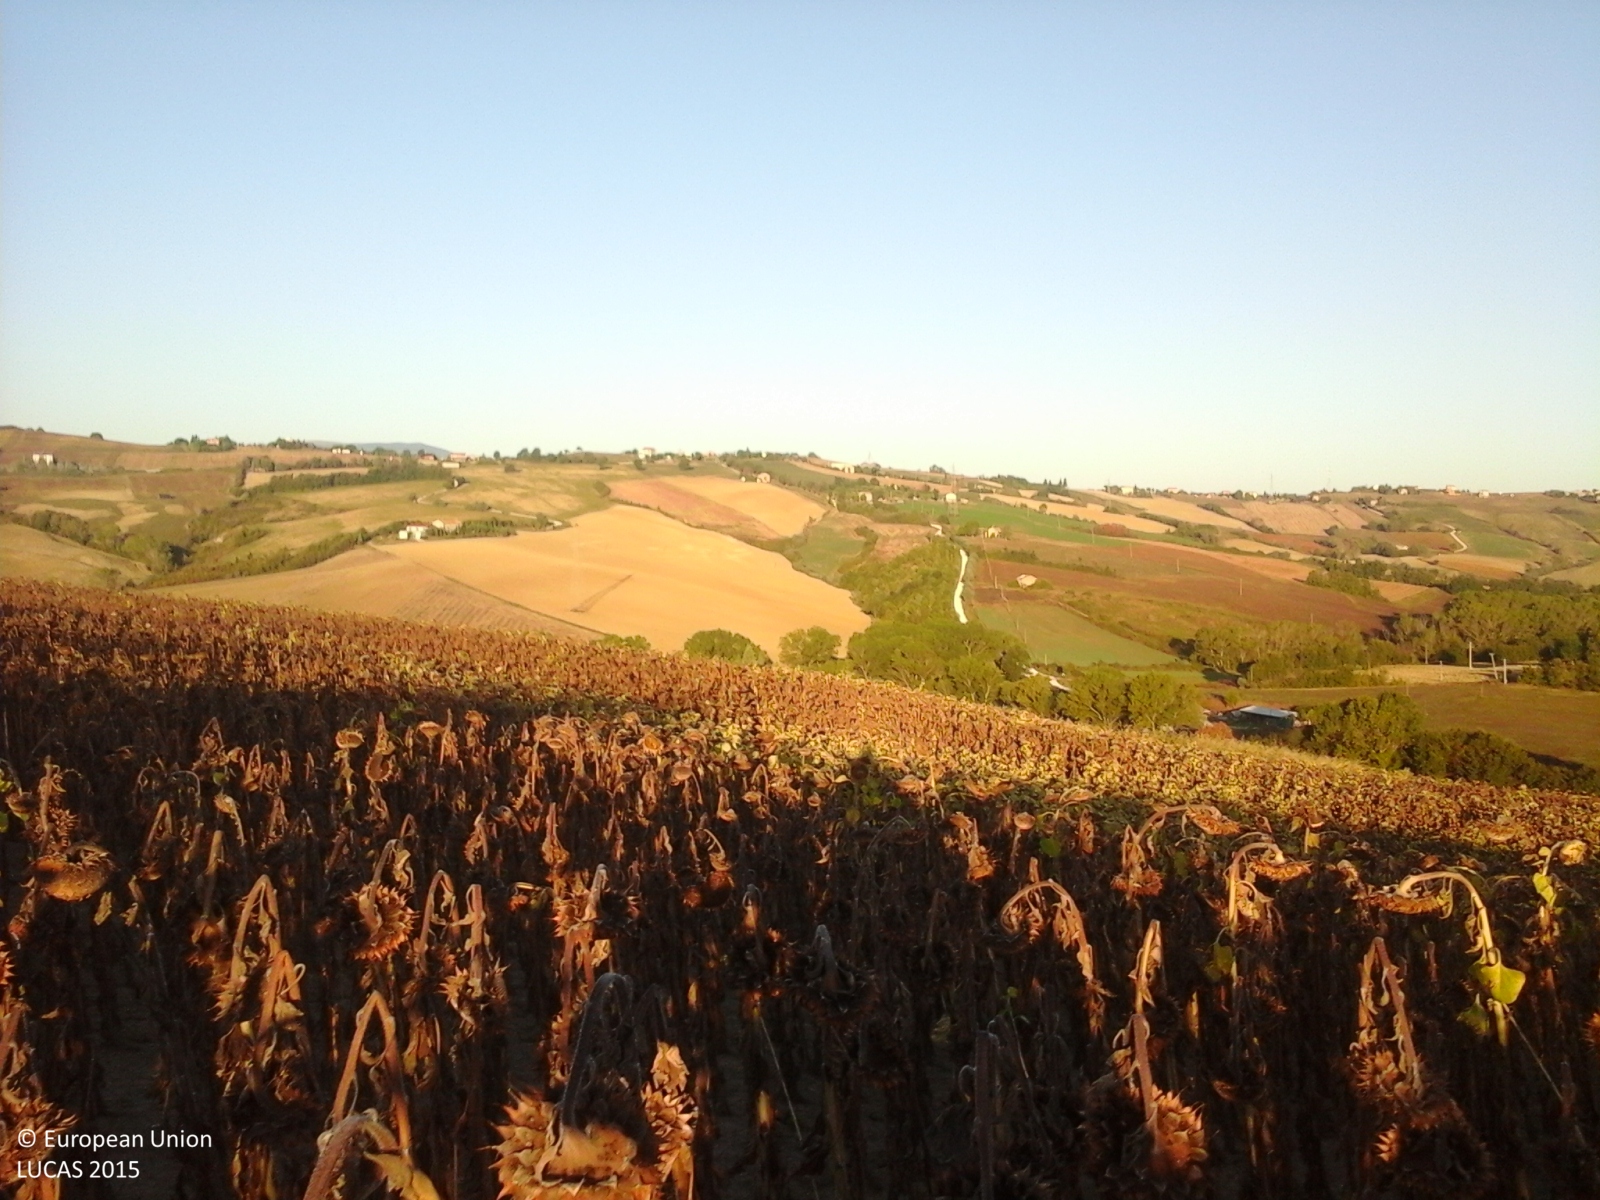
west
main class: Cropland
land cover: Sunflower
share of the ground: > 75 %
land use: Agriculture (excluding fallow land and kitchen gardens)
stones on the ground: < 10 %
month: September
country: IT
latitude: 43.6932
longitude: 13.0077
